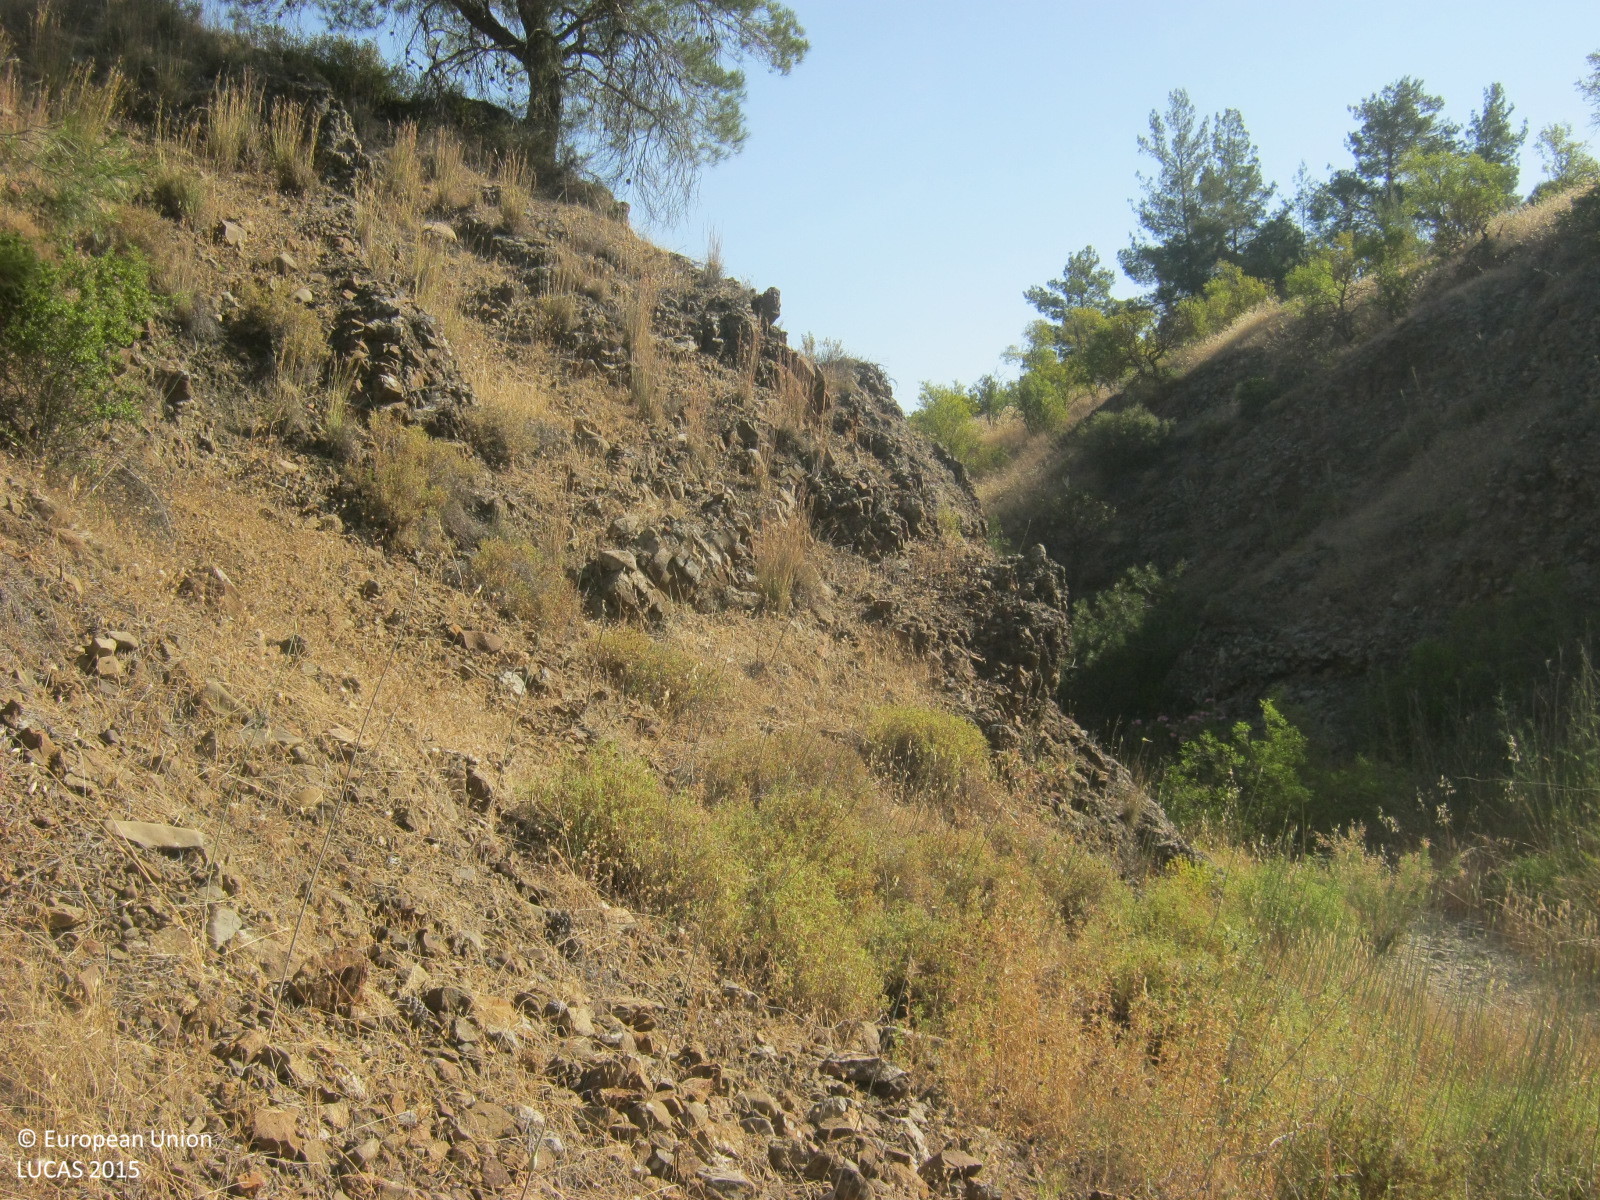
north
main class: Shrubland
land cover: Shrubland with sparse tree cover
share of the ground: 25 - 50 %
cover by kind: shrubs 30 %, herbaceous plants 30 %, consolidated bare surface 20 %, unconsolidated bare surface 15 %, coniferous forest trees 5 %
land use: Semi-natural and natural areas not in use
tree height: > 5 m
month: June
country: CY
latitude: 35.0368
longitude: 33.0770
